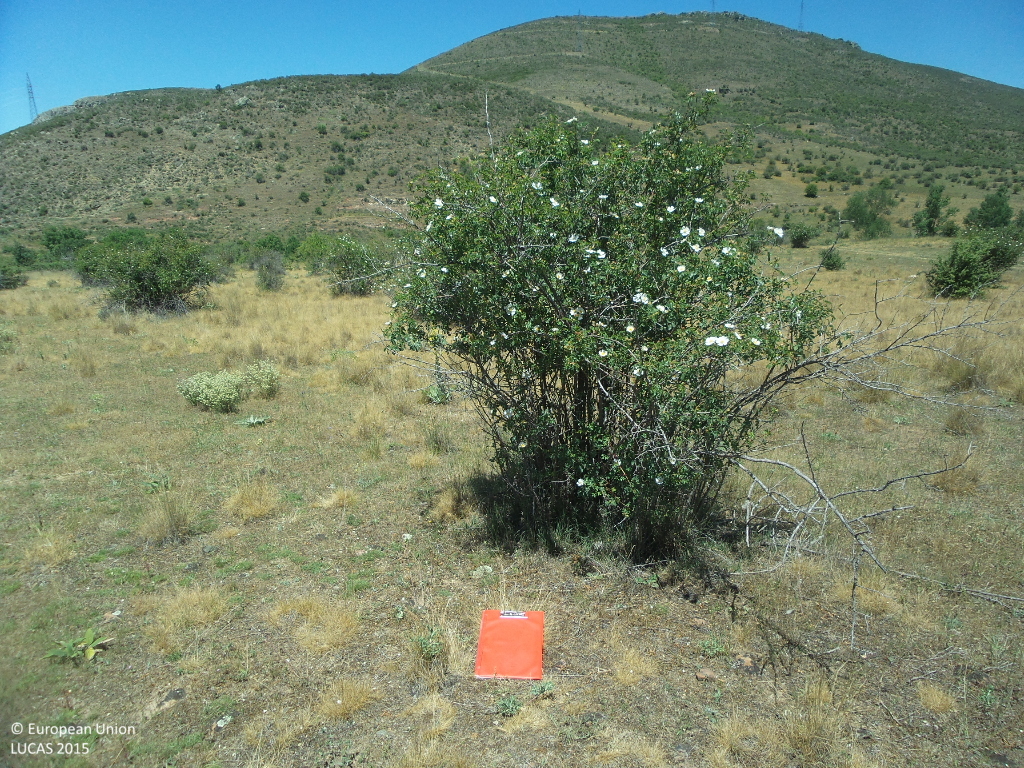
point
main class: Shrubland
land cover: Shrubland without tree cover
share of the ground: 10 - 25 %
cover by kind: herbaceous plants 70 %, shrubs 20 %, unconsolidated bare surface 10 %
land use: Semi-natural and natural areas not in use
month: June
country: ES
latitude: 41.1649
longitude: -2.9203
